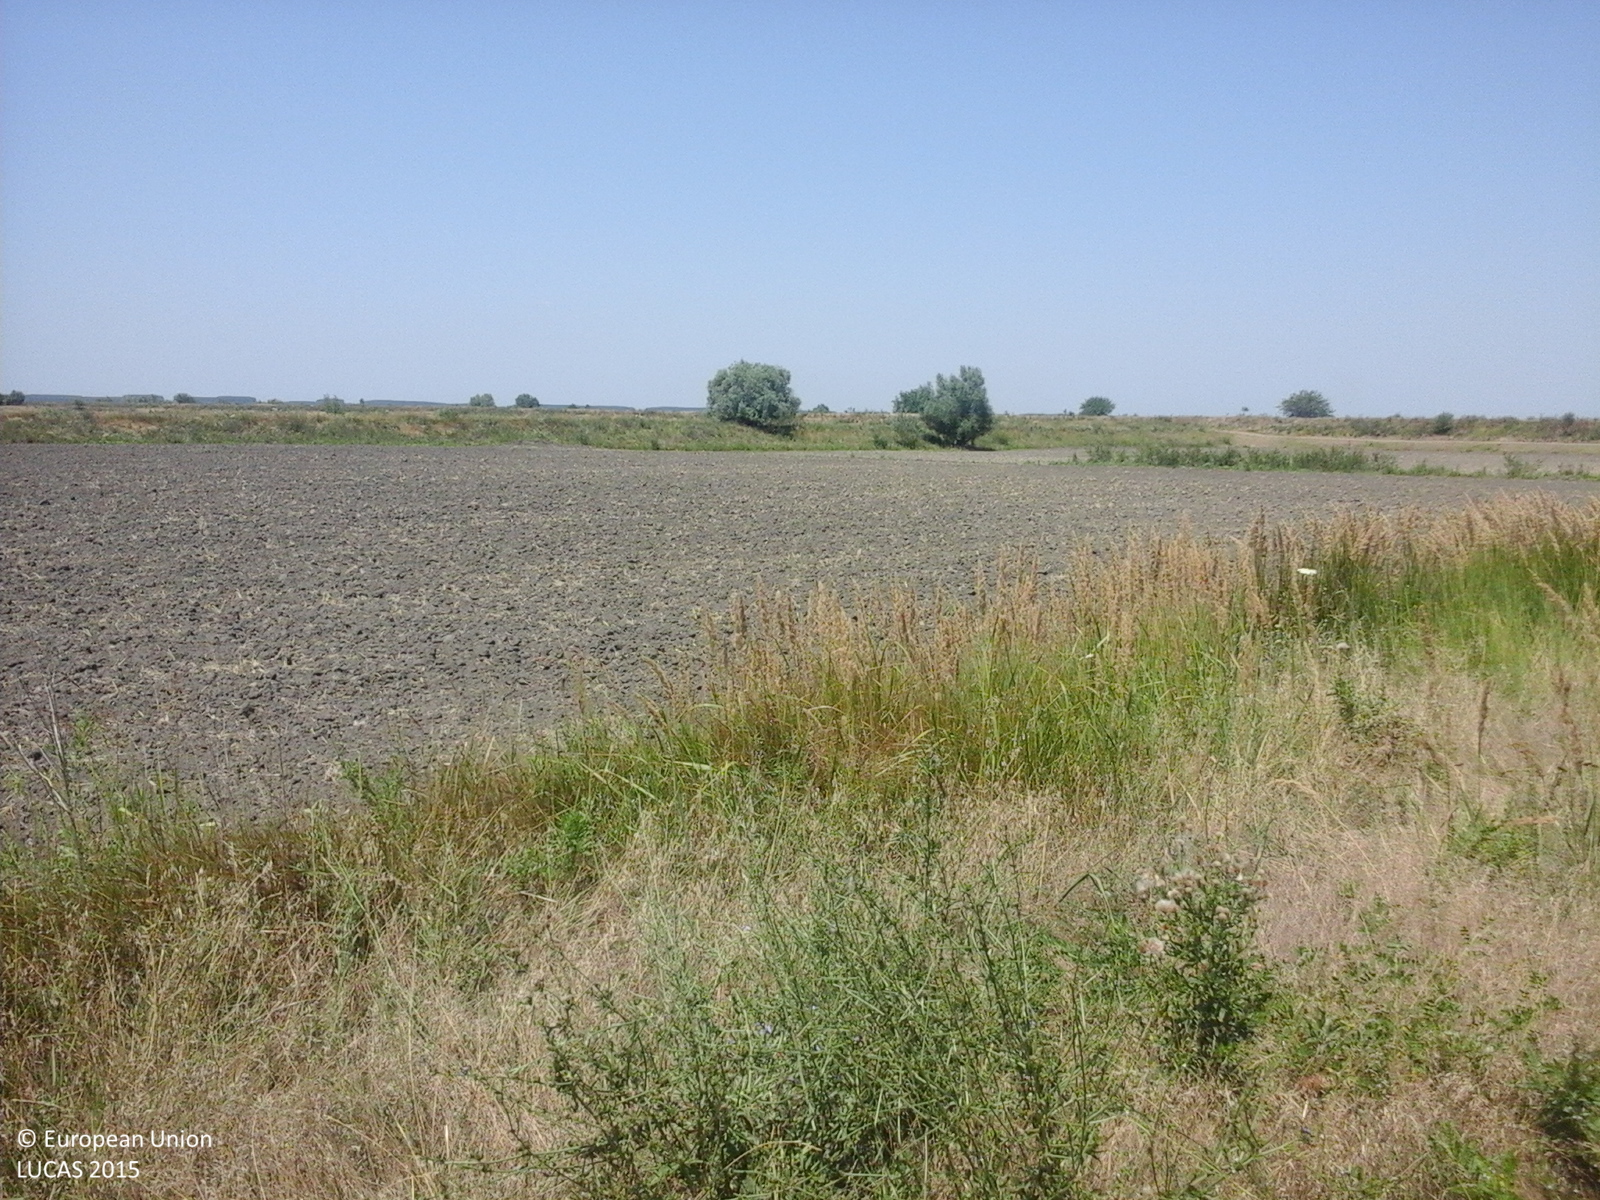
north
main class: Grassland
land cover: Spontaneously vegetated surfaces
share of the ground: > 75 %
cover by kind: herbaceous plants 100 %
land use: Semi-natural and natural areas not in use
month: July
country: RO
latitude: 44.1602
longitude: 27.4824
